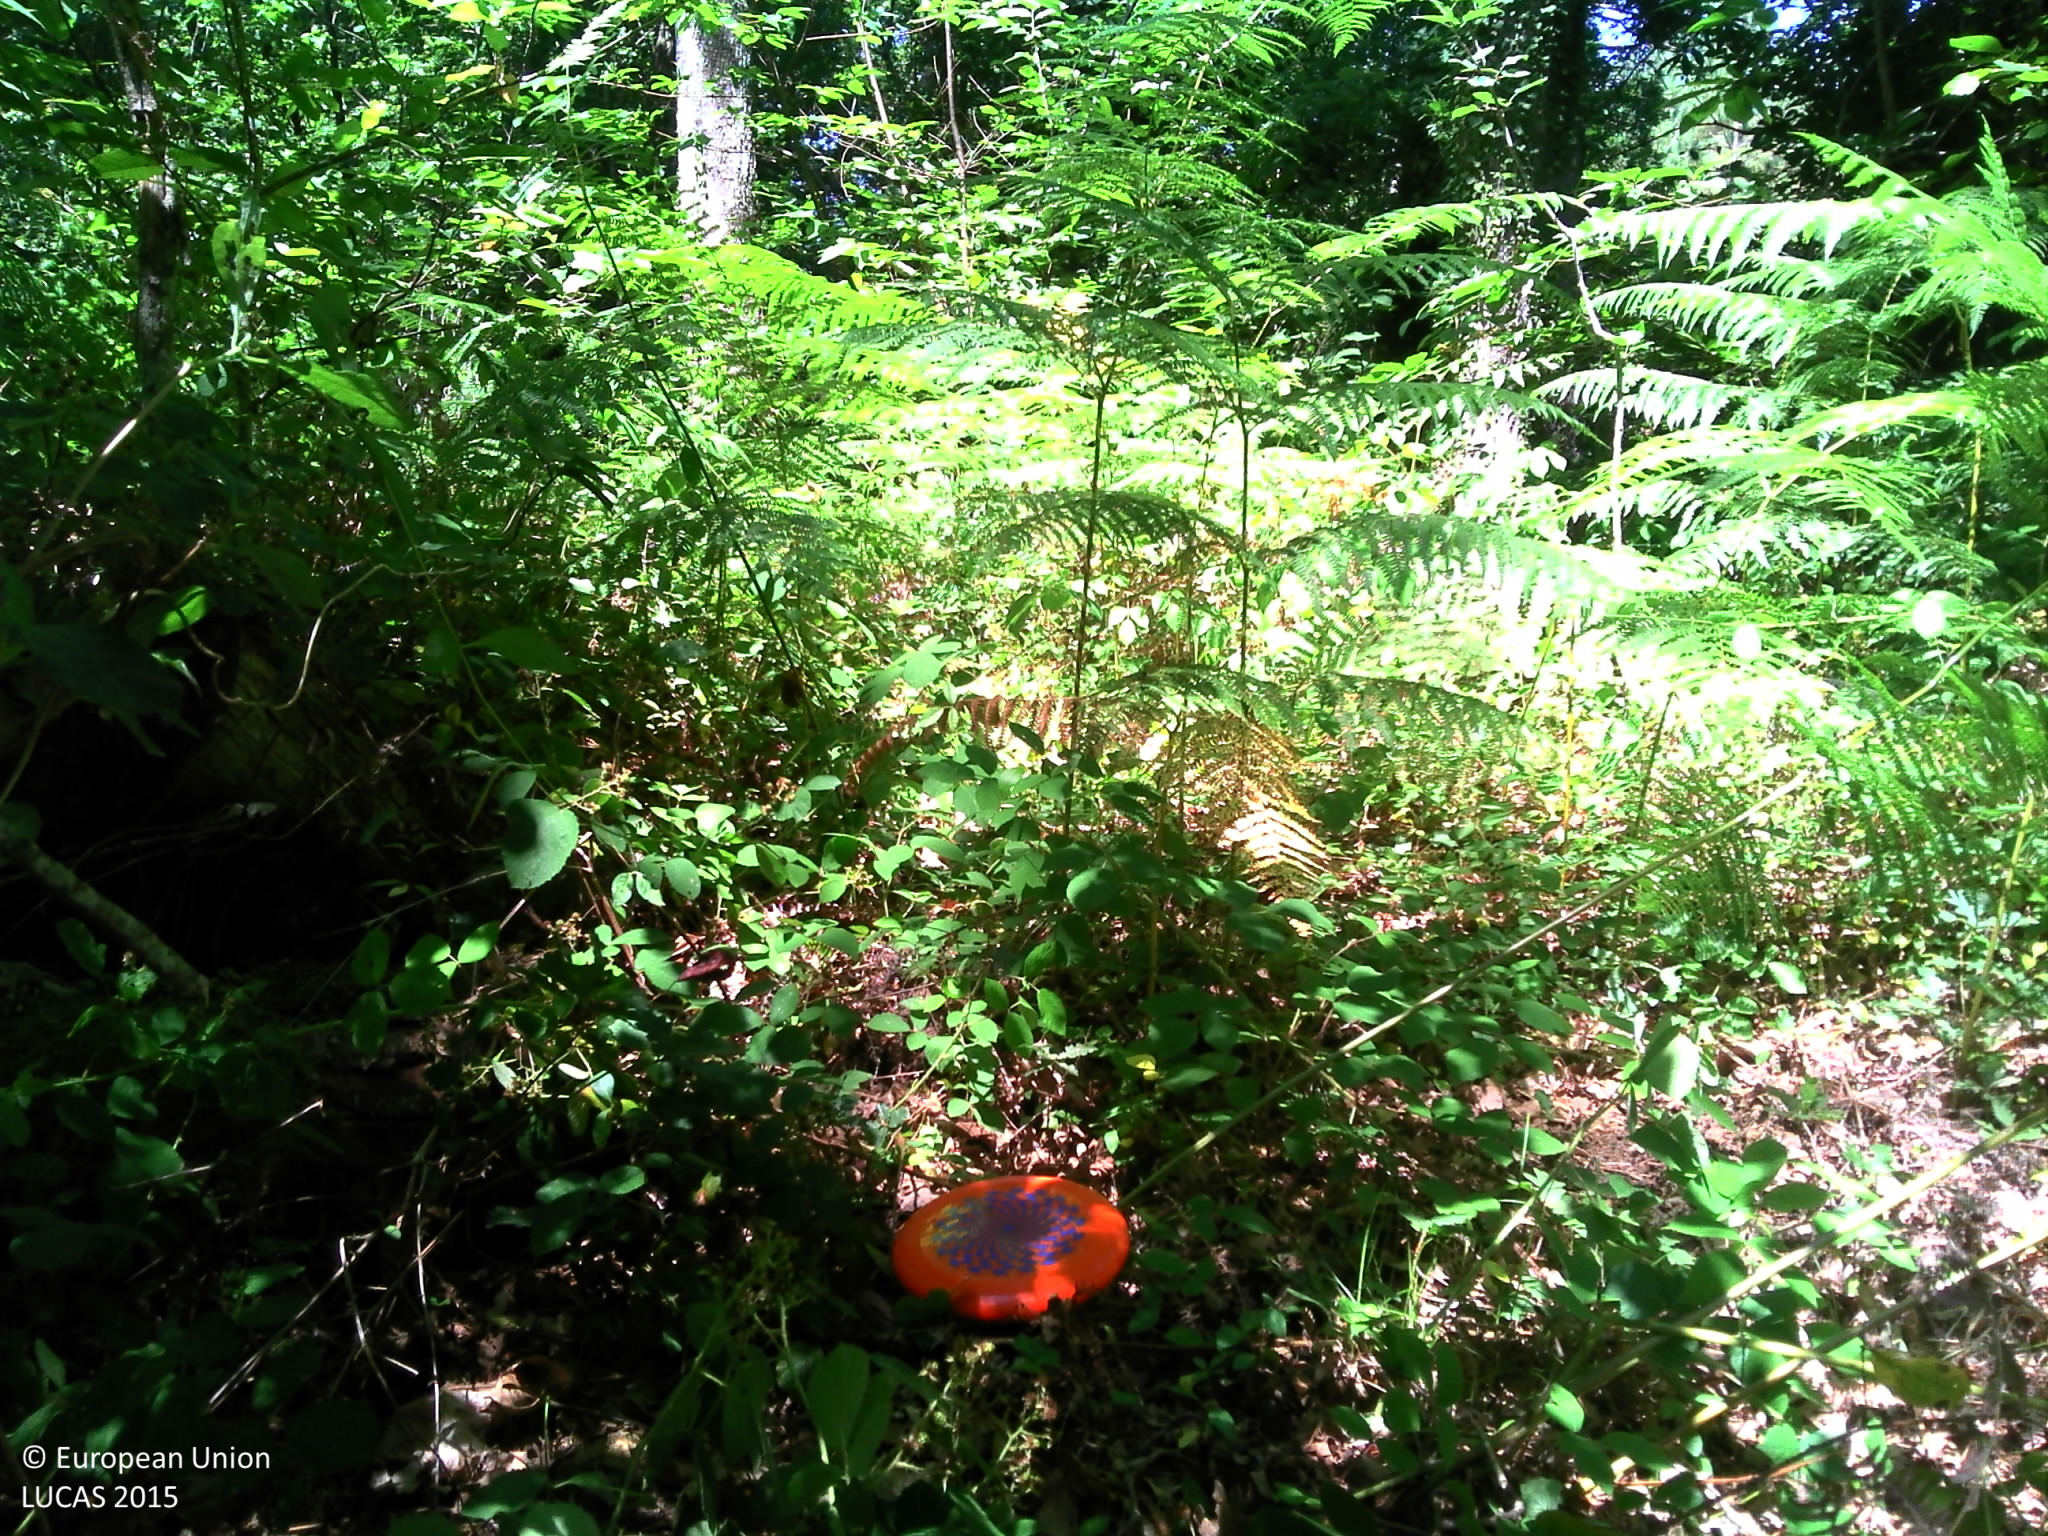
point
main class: Woodland
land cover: Broadleaved woodland
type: thermophilous deciduous forest
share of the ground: > 75 %
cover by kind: broadleaved forest trees 85 %, herbaceous plants 15 %
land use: Forestry
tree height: > 5 m
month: June
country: FR
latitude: 44.5637
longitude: 0.8660
